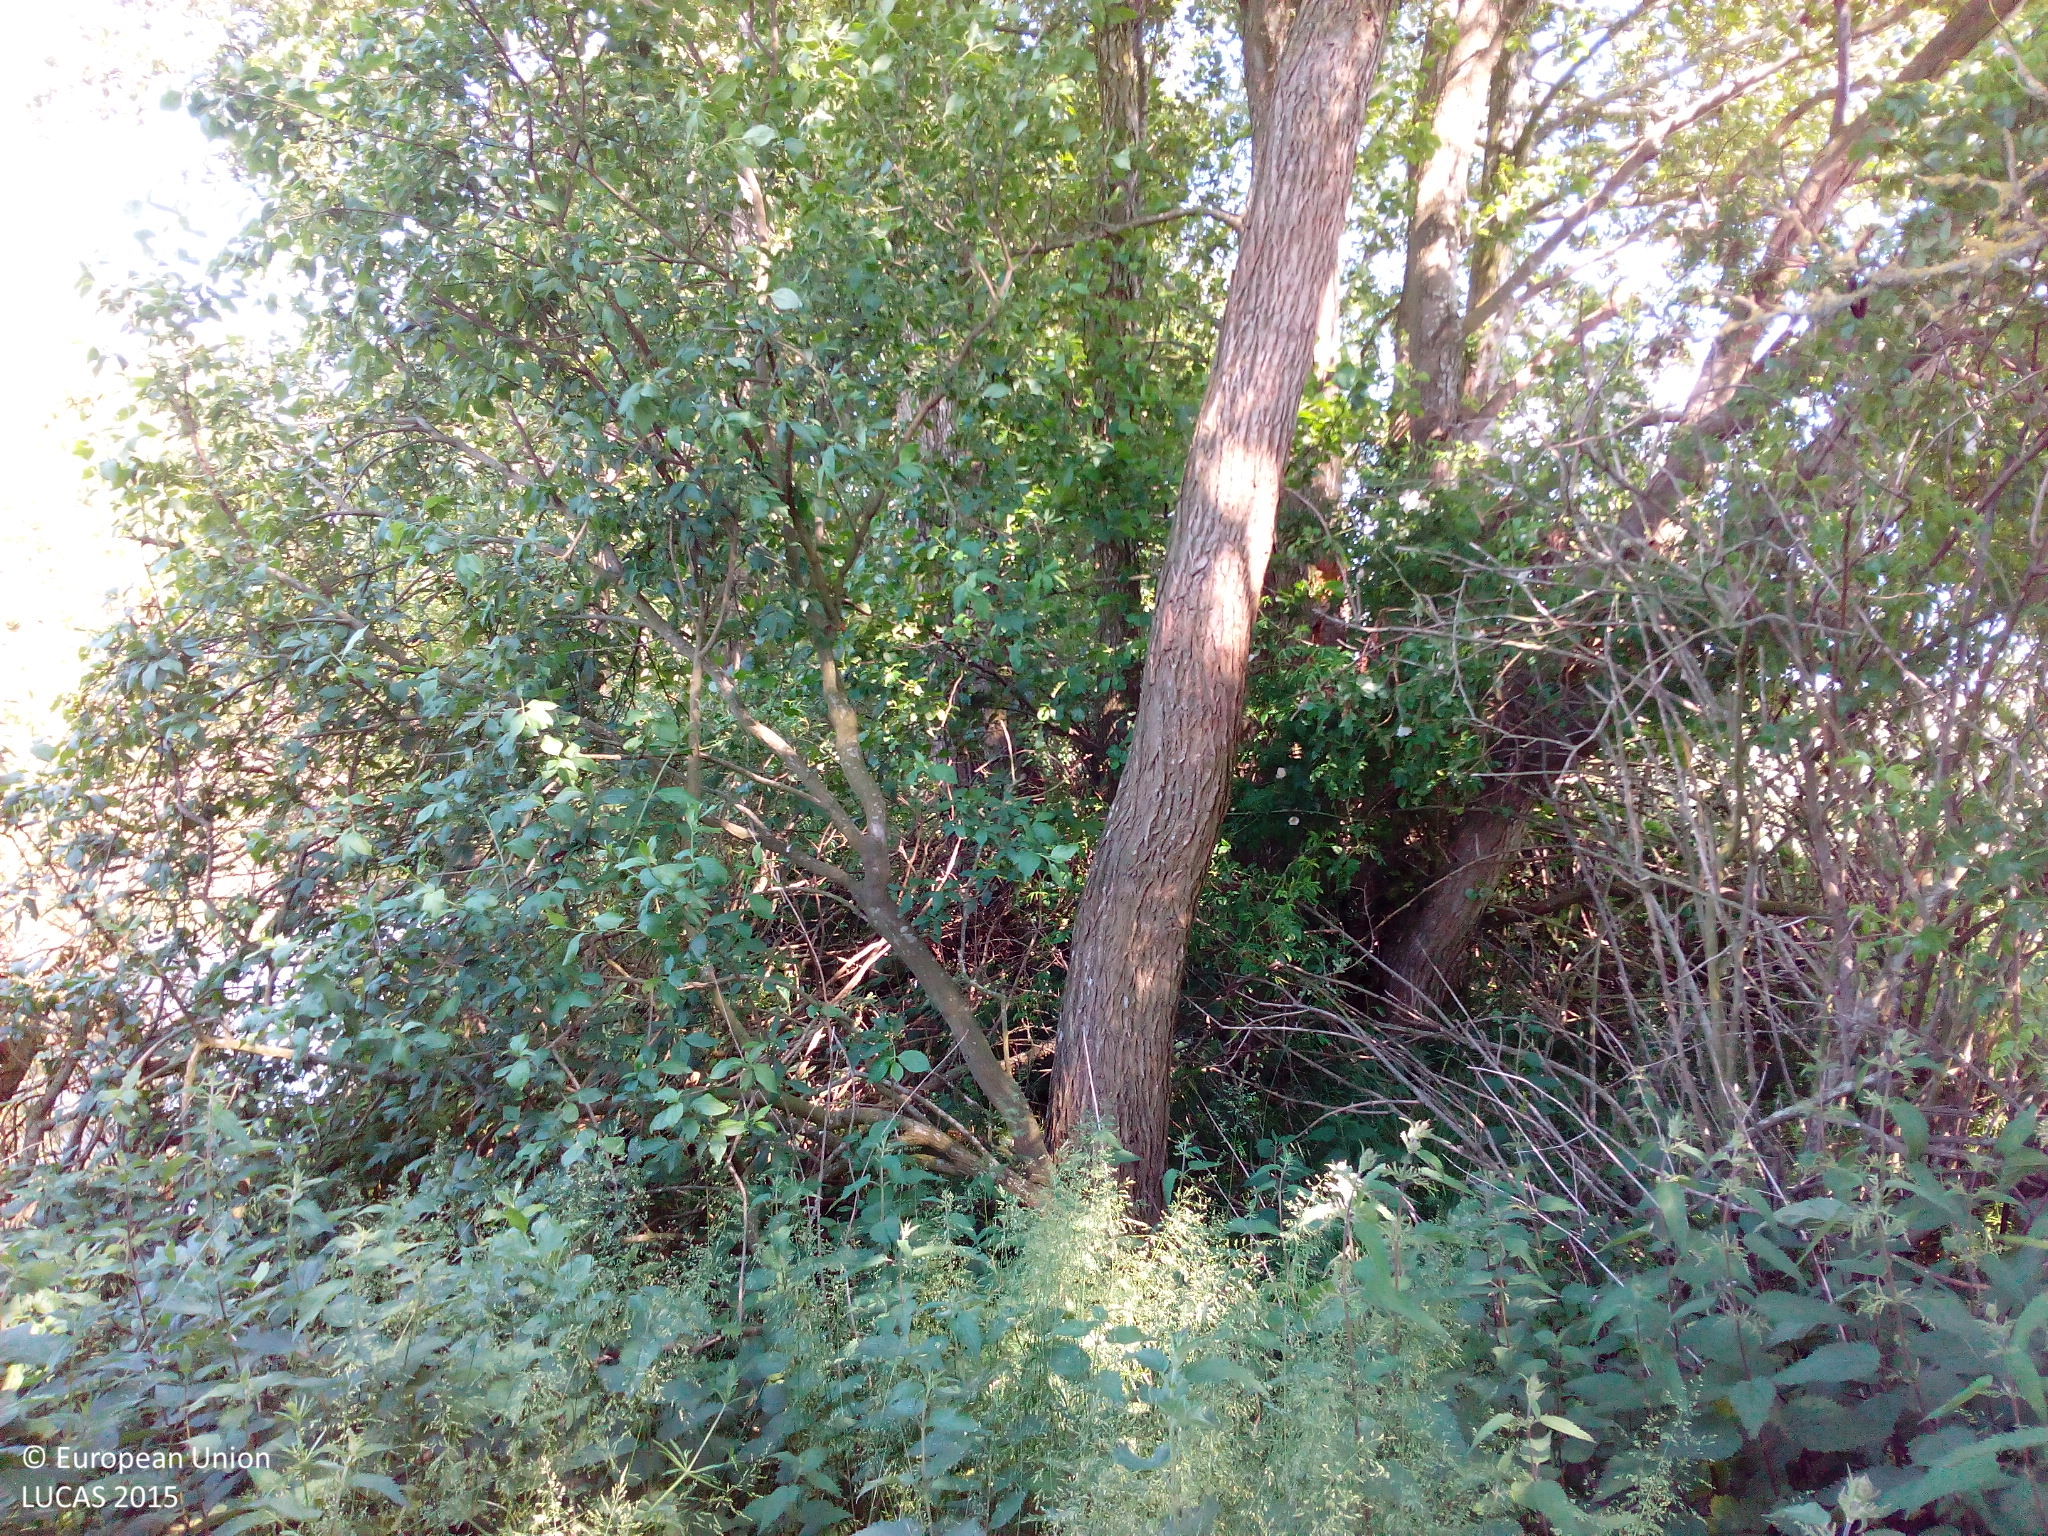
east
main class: Woodland
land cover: Broadleaved woodland
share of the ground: 50 - 75 %
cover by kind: broadleaved forest trees 55 %, herbaceous plants 35 %, shrubs 10 %
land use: Semi-natural and natural areas not in use
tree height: > 5 m
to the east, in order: Broadleaved woodland; Inland fresh water bodies; Broadleaved woodland; Grass margins; Common wheat
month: June
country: DK
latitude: 56.3113
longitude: 10.7588
